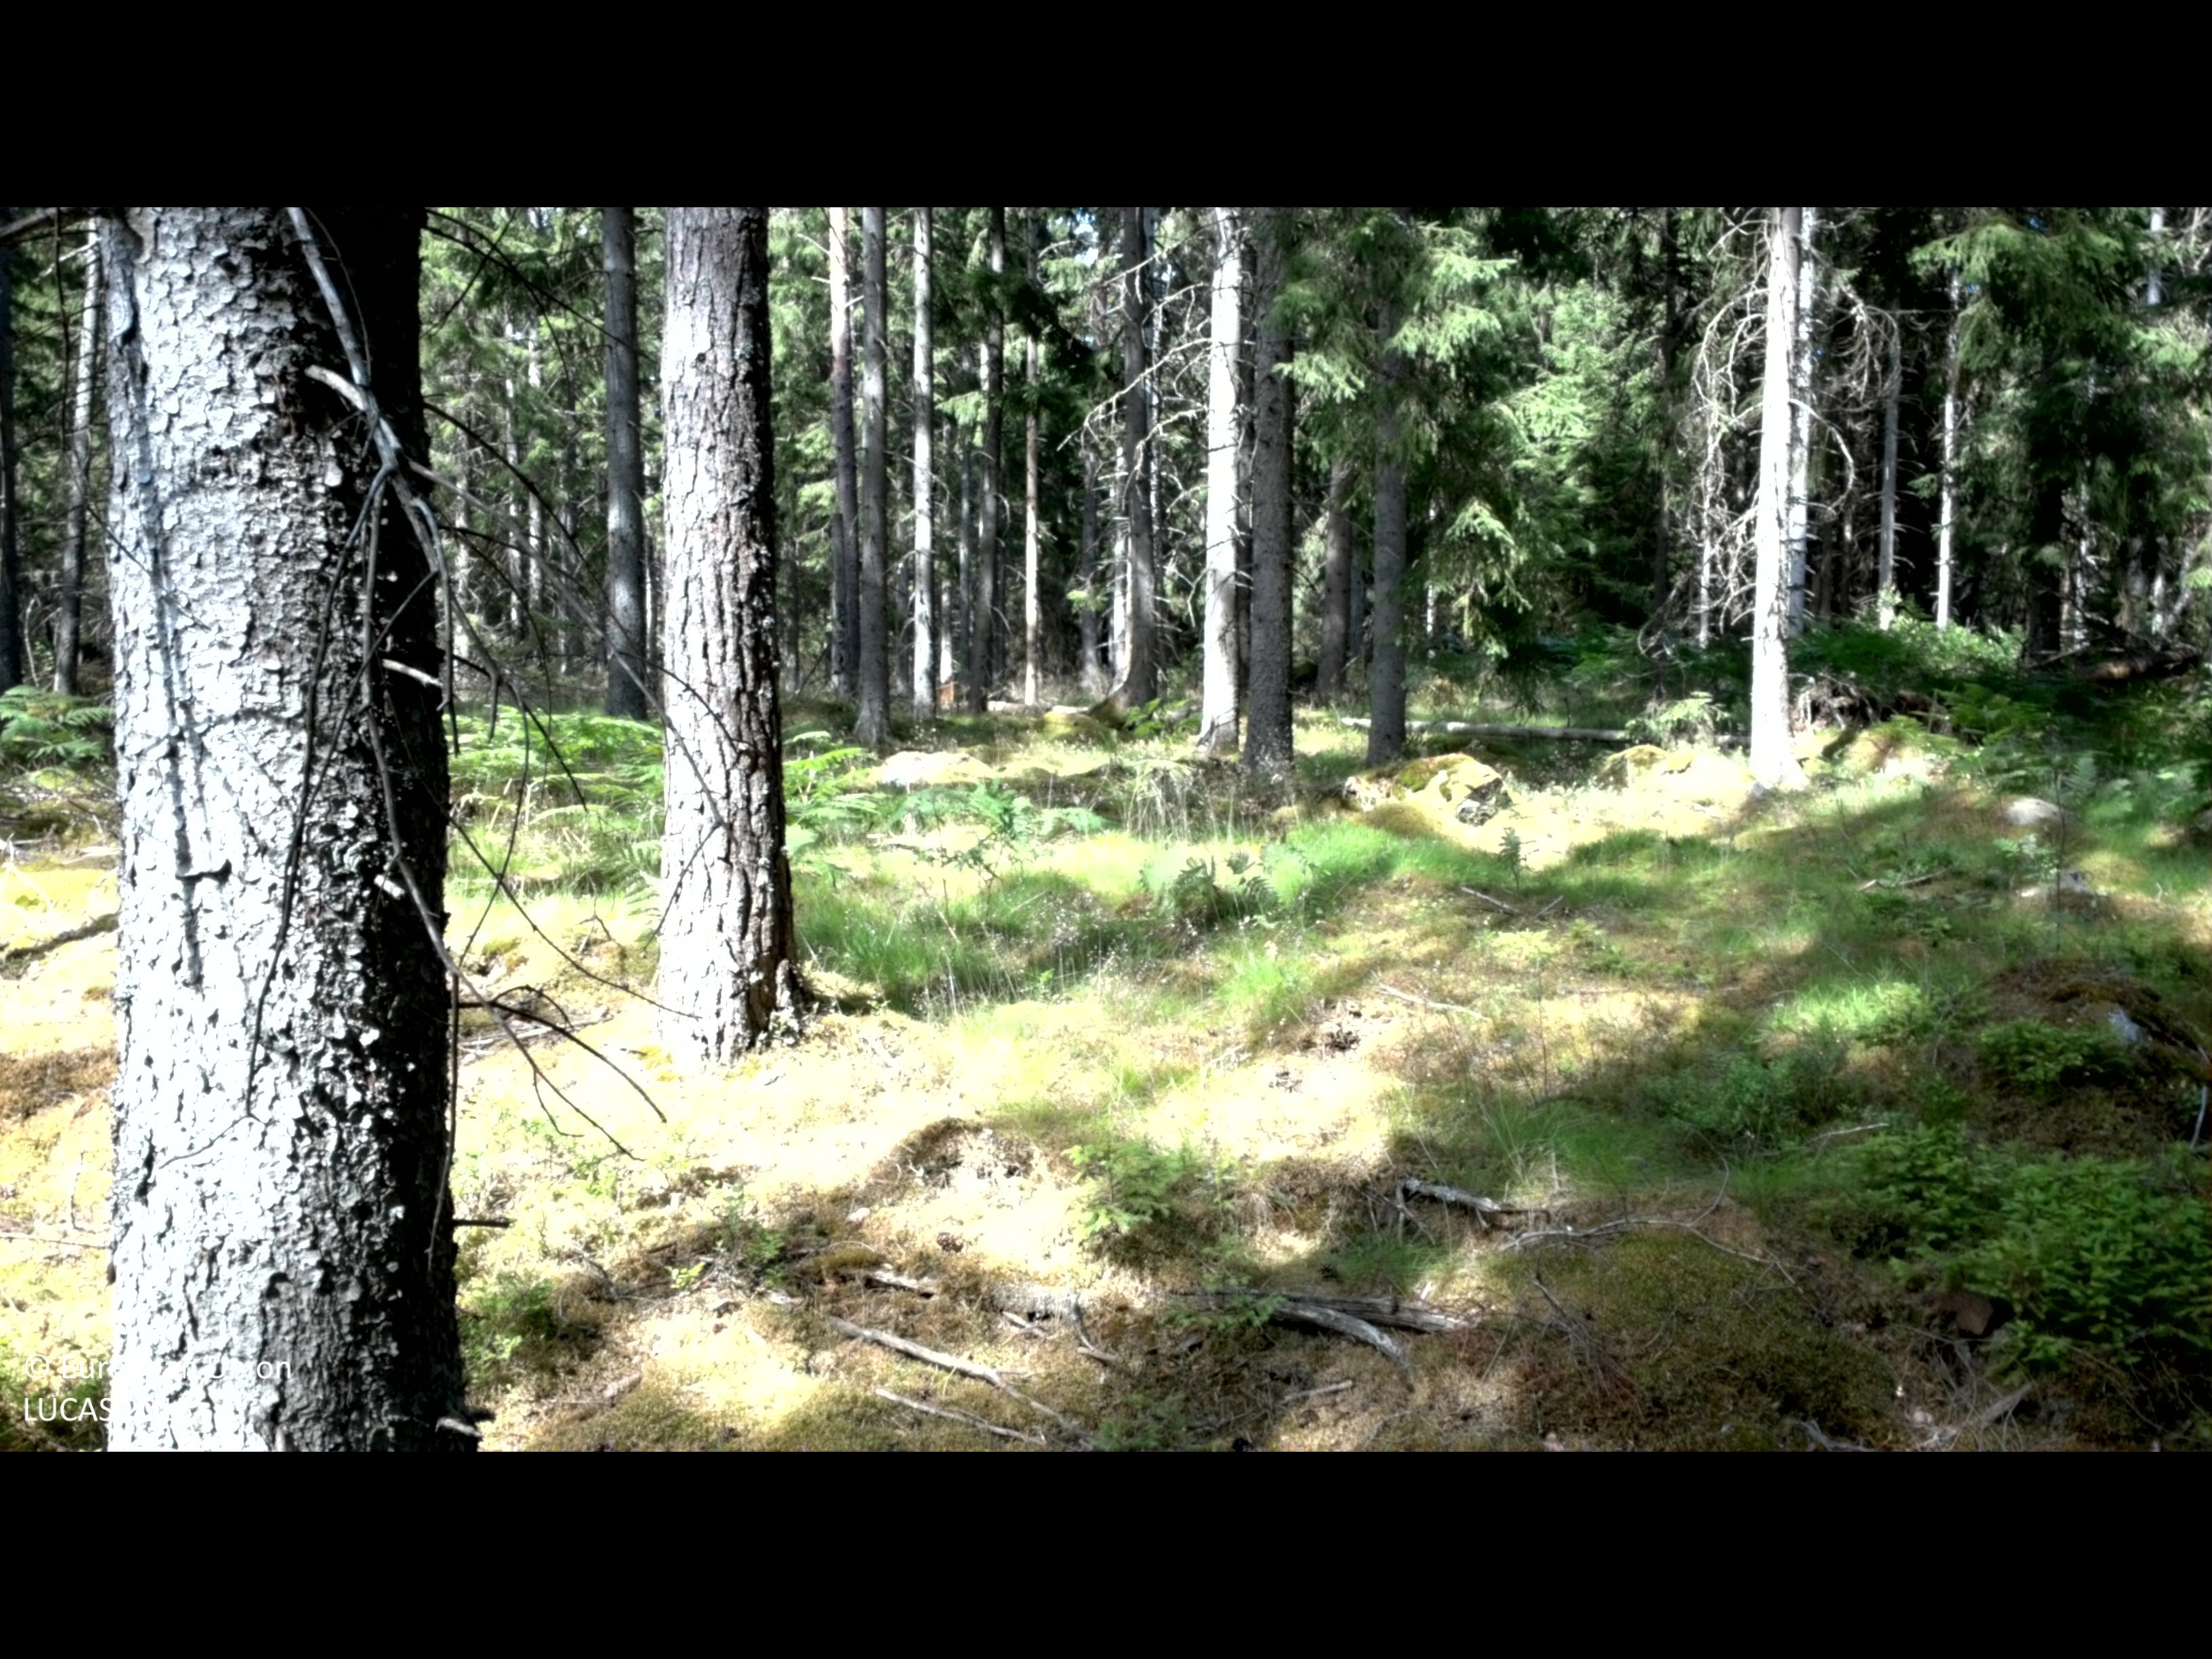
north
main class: Woodland
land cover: Spruce dominated coniferous woodland
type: boreal forest
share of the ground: 50 - 75 %
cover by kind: coniferous forest trees 60 %, lichens and mosses 20 %, shrubs 15 %, herbaceous plants 5 %
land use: Forestry
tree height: > 5 m
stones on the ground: 25 - 50 %
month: July
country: SE
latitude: 56.4850
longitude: 14.5607
